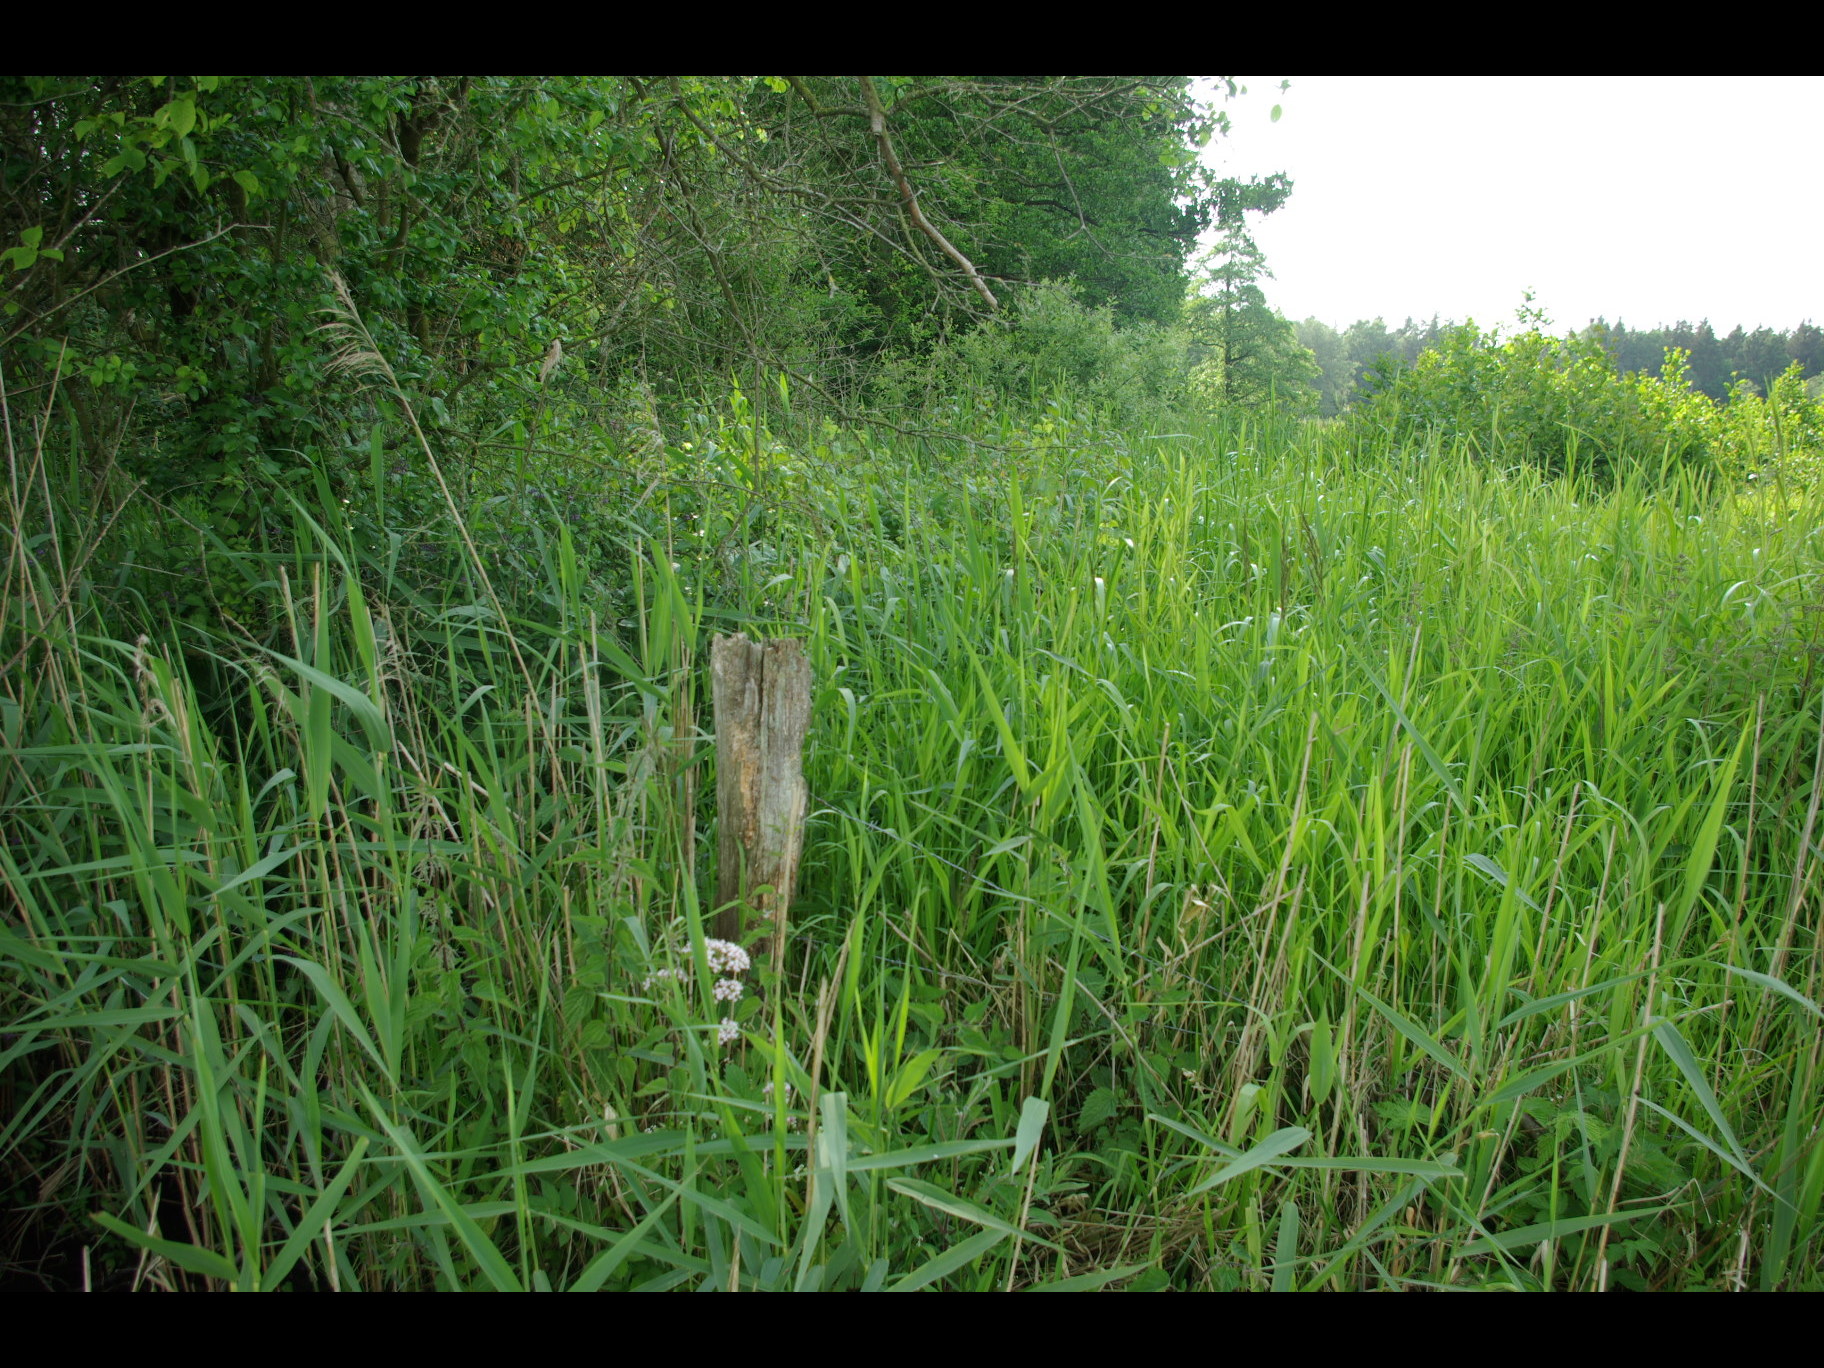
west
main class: Woodland
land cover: Broadleaved woodland
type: mire and swamp forests
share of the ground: > 75 %
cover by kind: broadleaved forest trees 60 %, herbaceous plants 30 %, shrubs 10 %
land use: Semi-natural and natural areas not in use
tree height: > 5 m
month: June
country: DE
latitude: 54.1927
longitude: 9.9234
